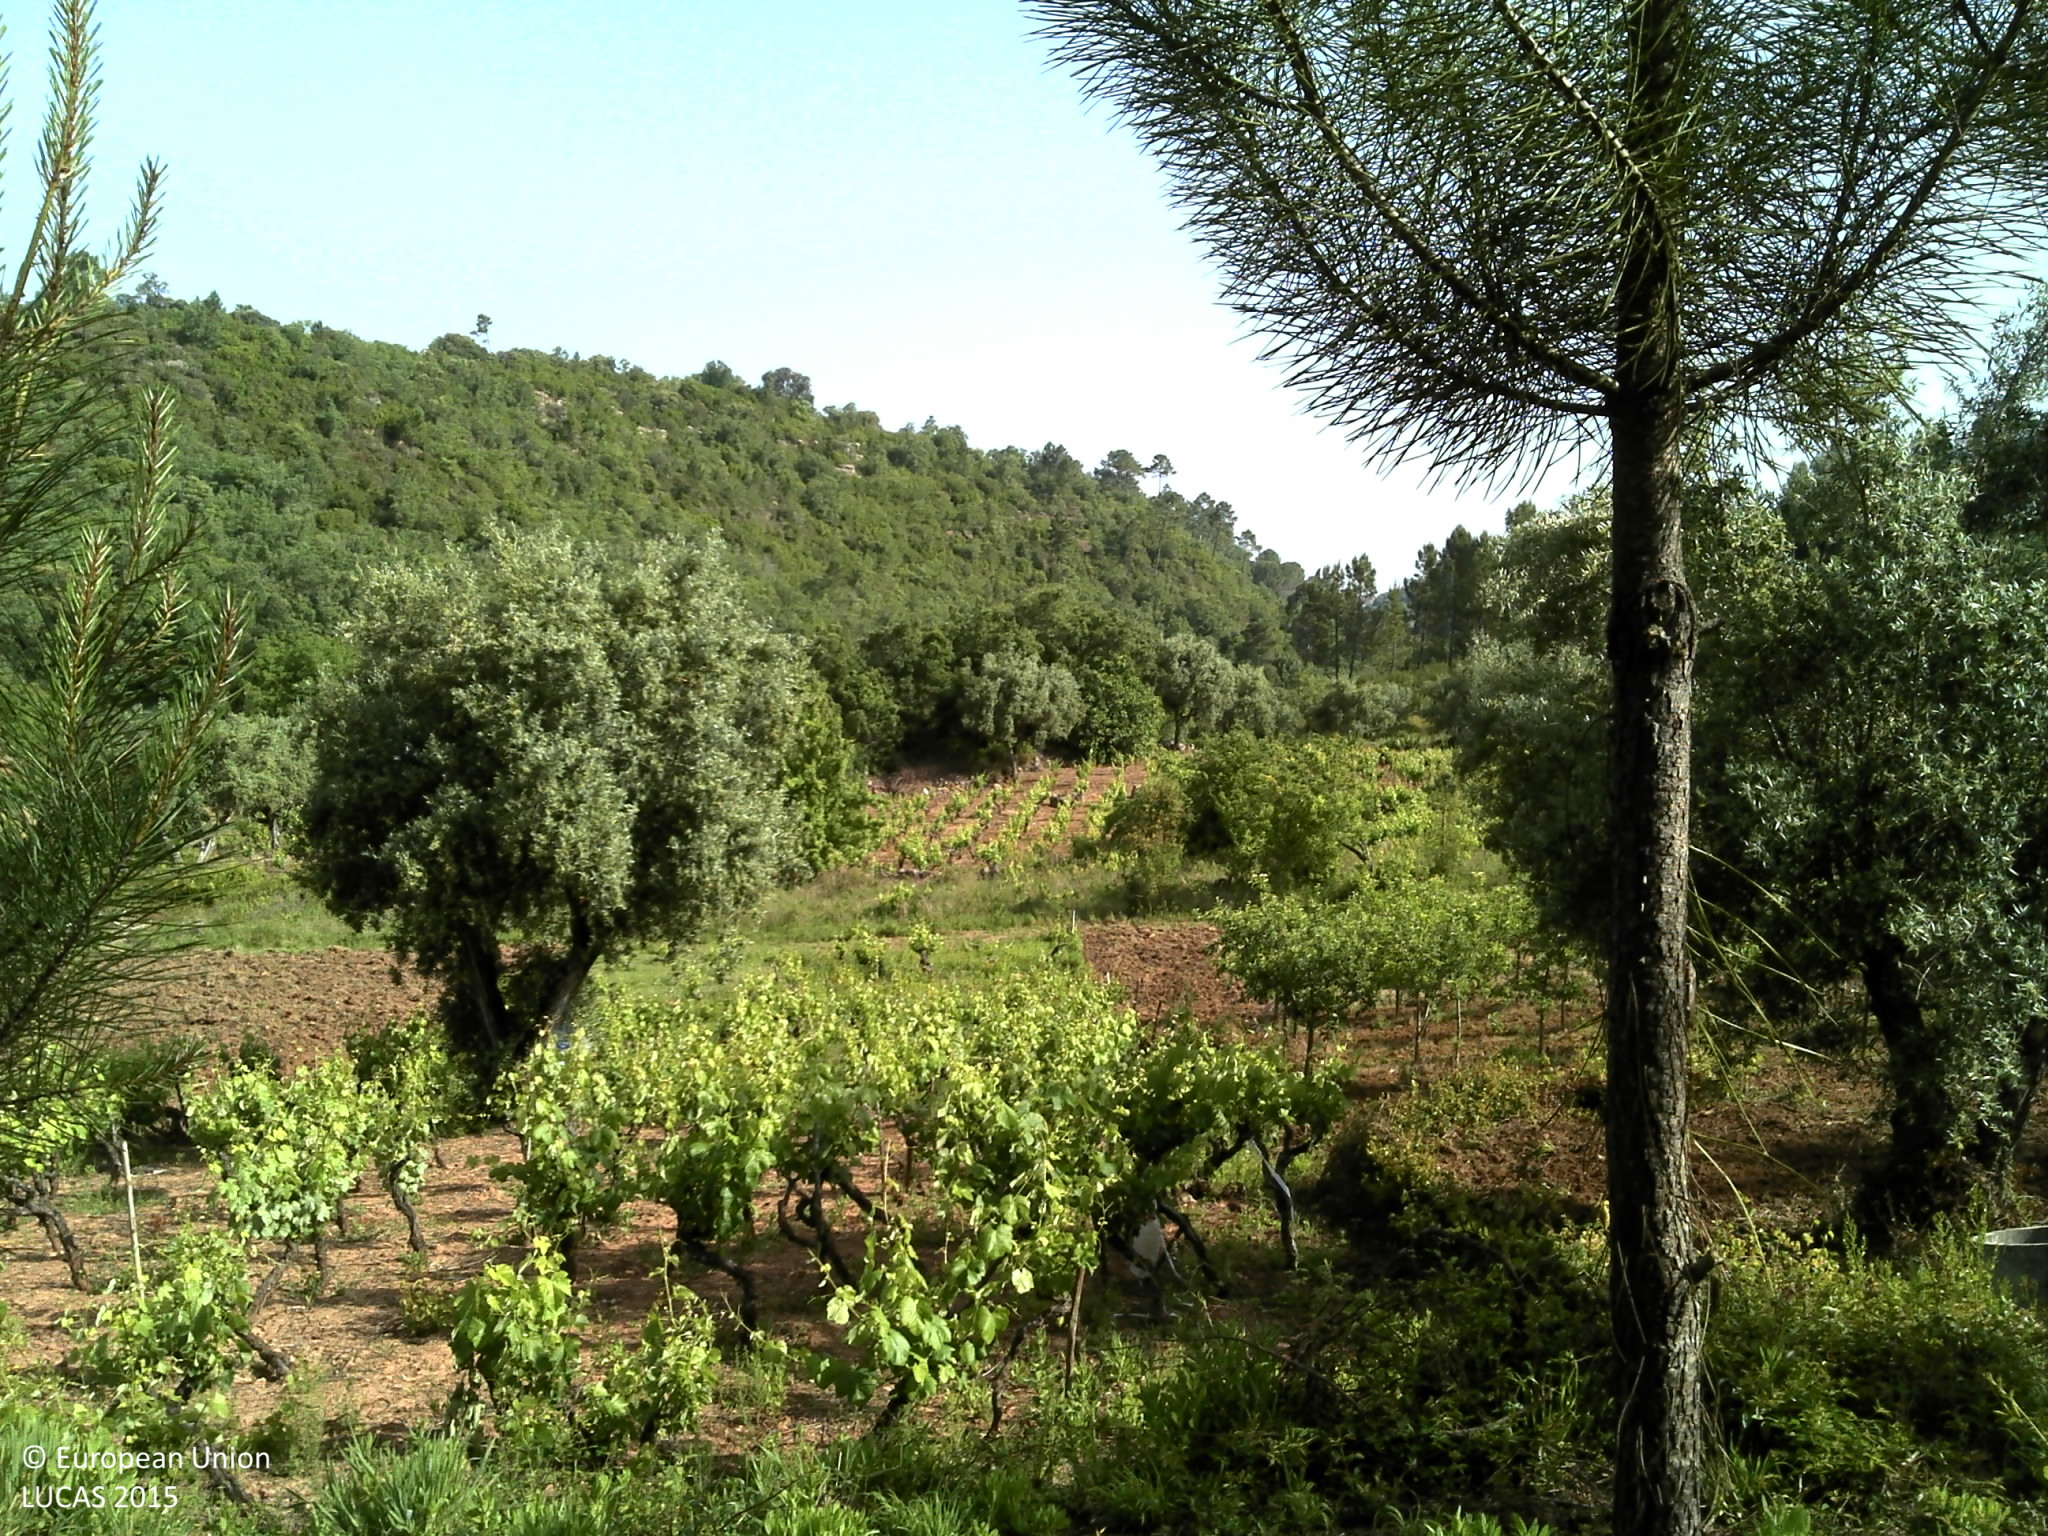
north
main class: Woodland
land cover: Pine dominated coniferous woodland
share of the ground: 50 - 75 %
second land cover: Grassland without tree/shrub cover
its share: 25 - 50 %
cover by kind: coniferous forest trees 85 %, herbaceous plants 15 %
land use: Forestry
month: May
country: PT
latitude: 39.6776
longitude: -8.3886
